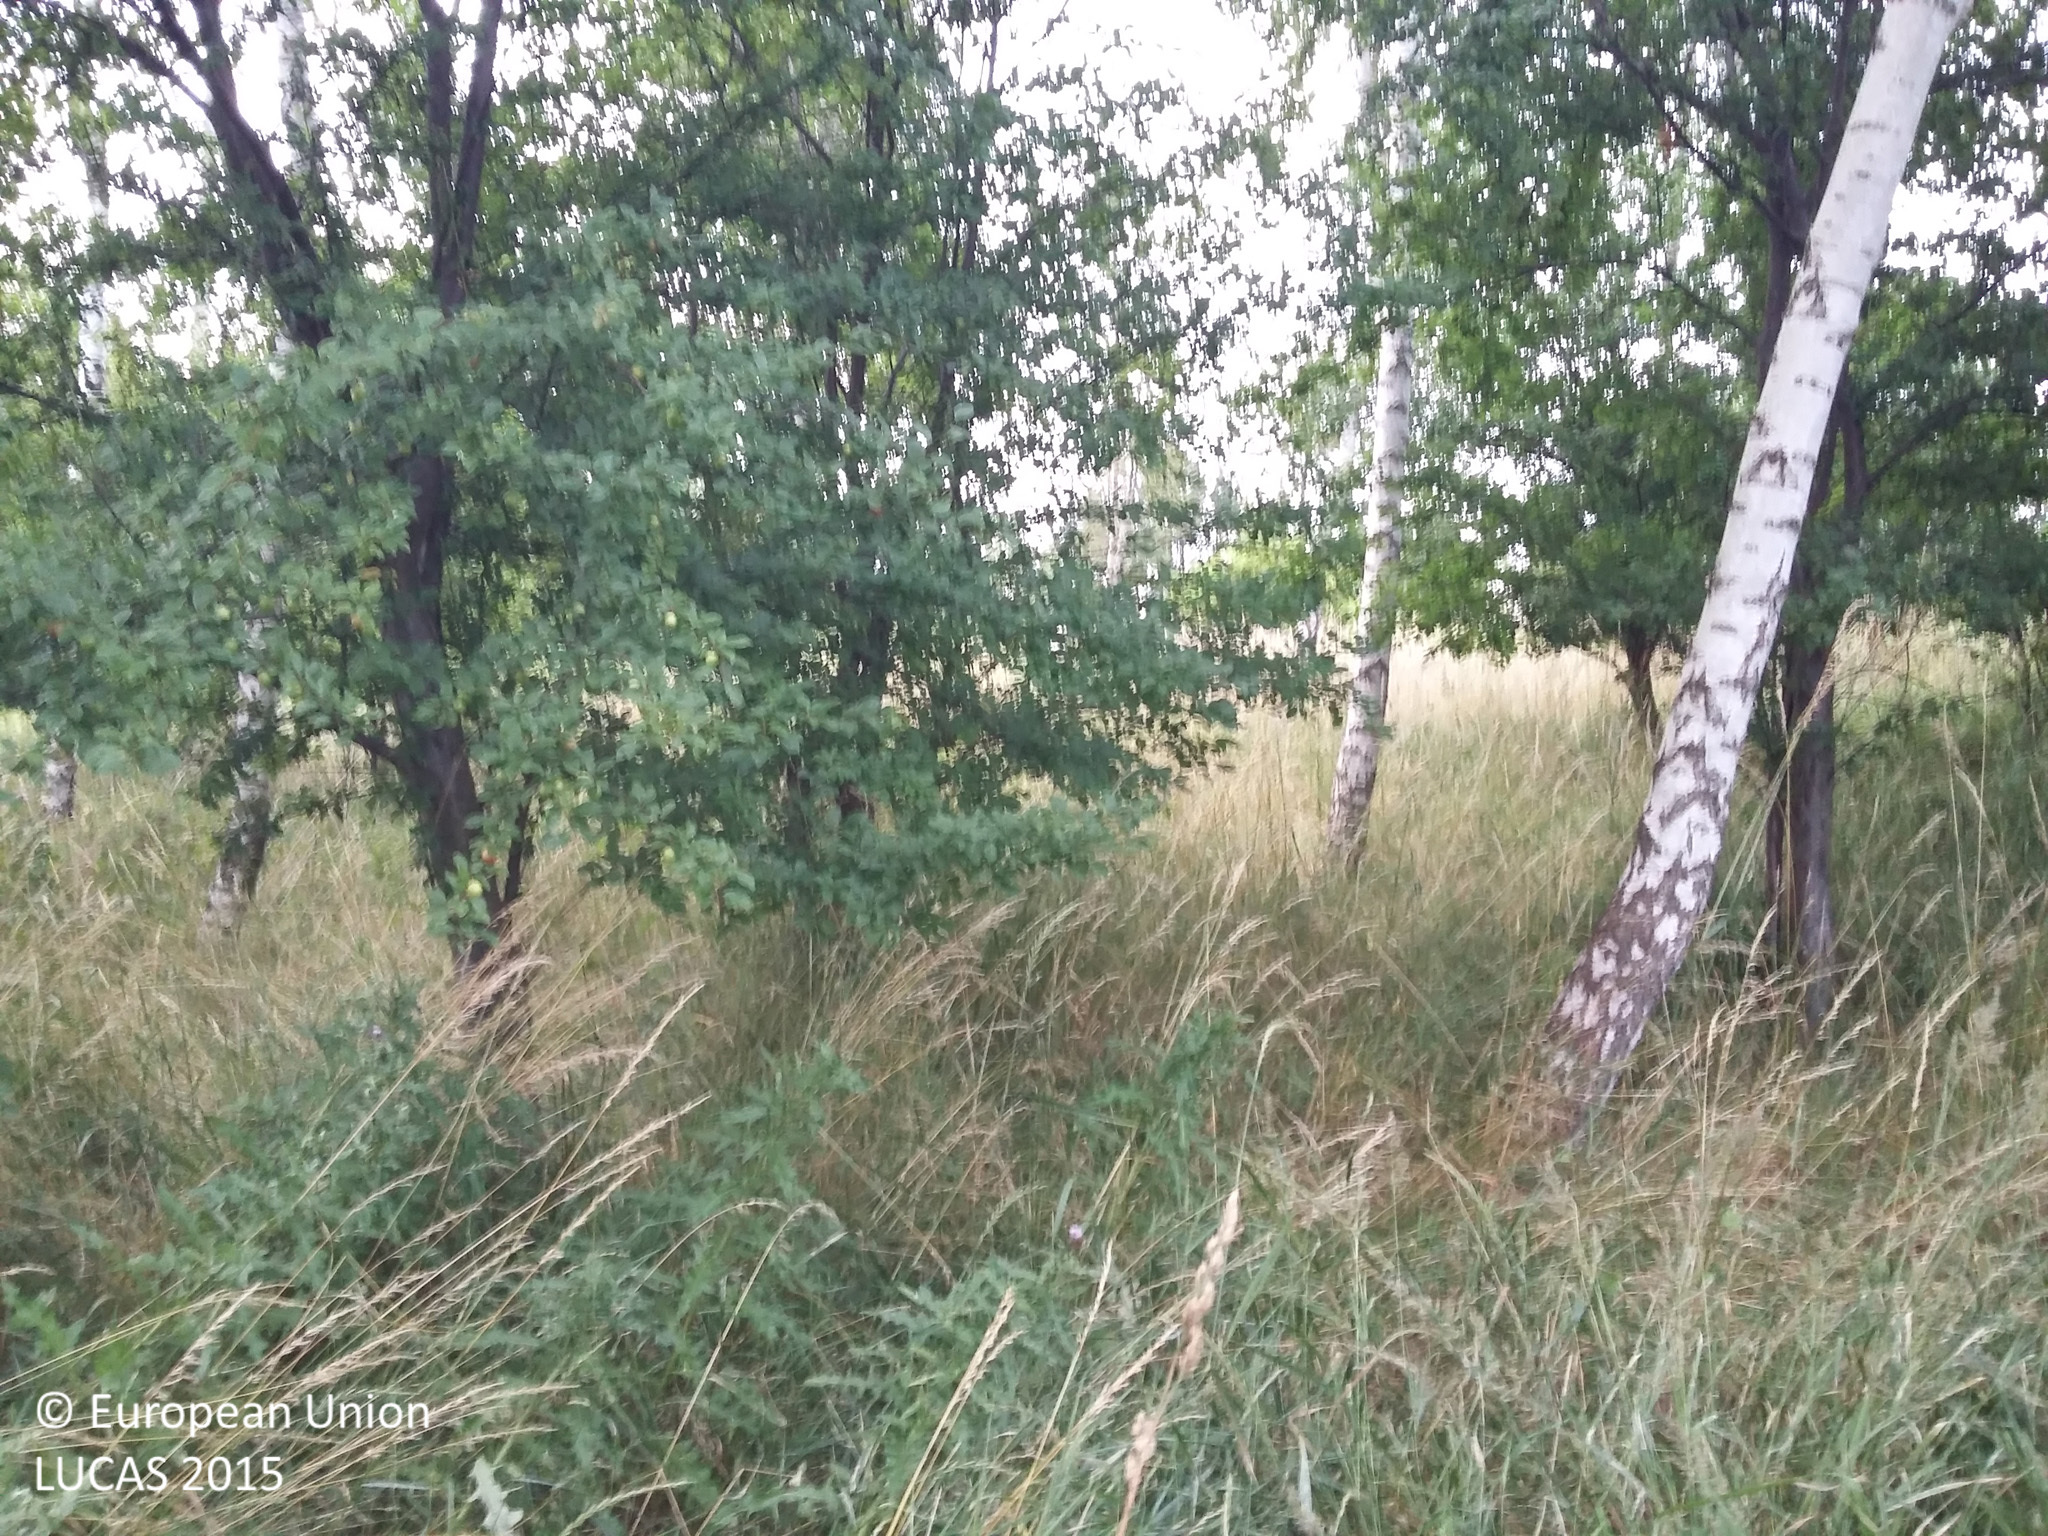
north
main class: Woodland
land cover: Broadleaved woodland
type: non-riverine alder, birch or aspen forest
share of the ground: > 75 %
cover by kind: broadleaved forest trees 70 %, herbaceous plants 30 %
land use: Community services
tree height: > 5 m
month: July
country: DK
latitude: 55.9035
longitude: 11.9335
